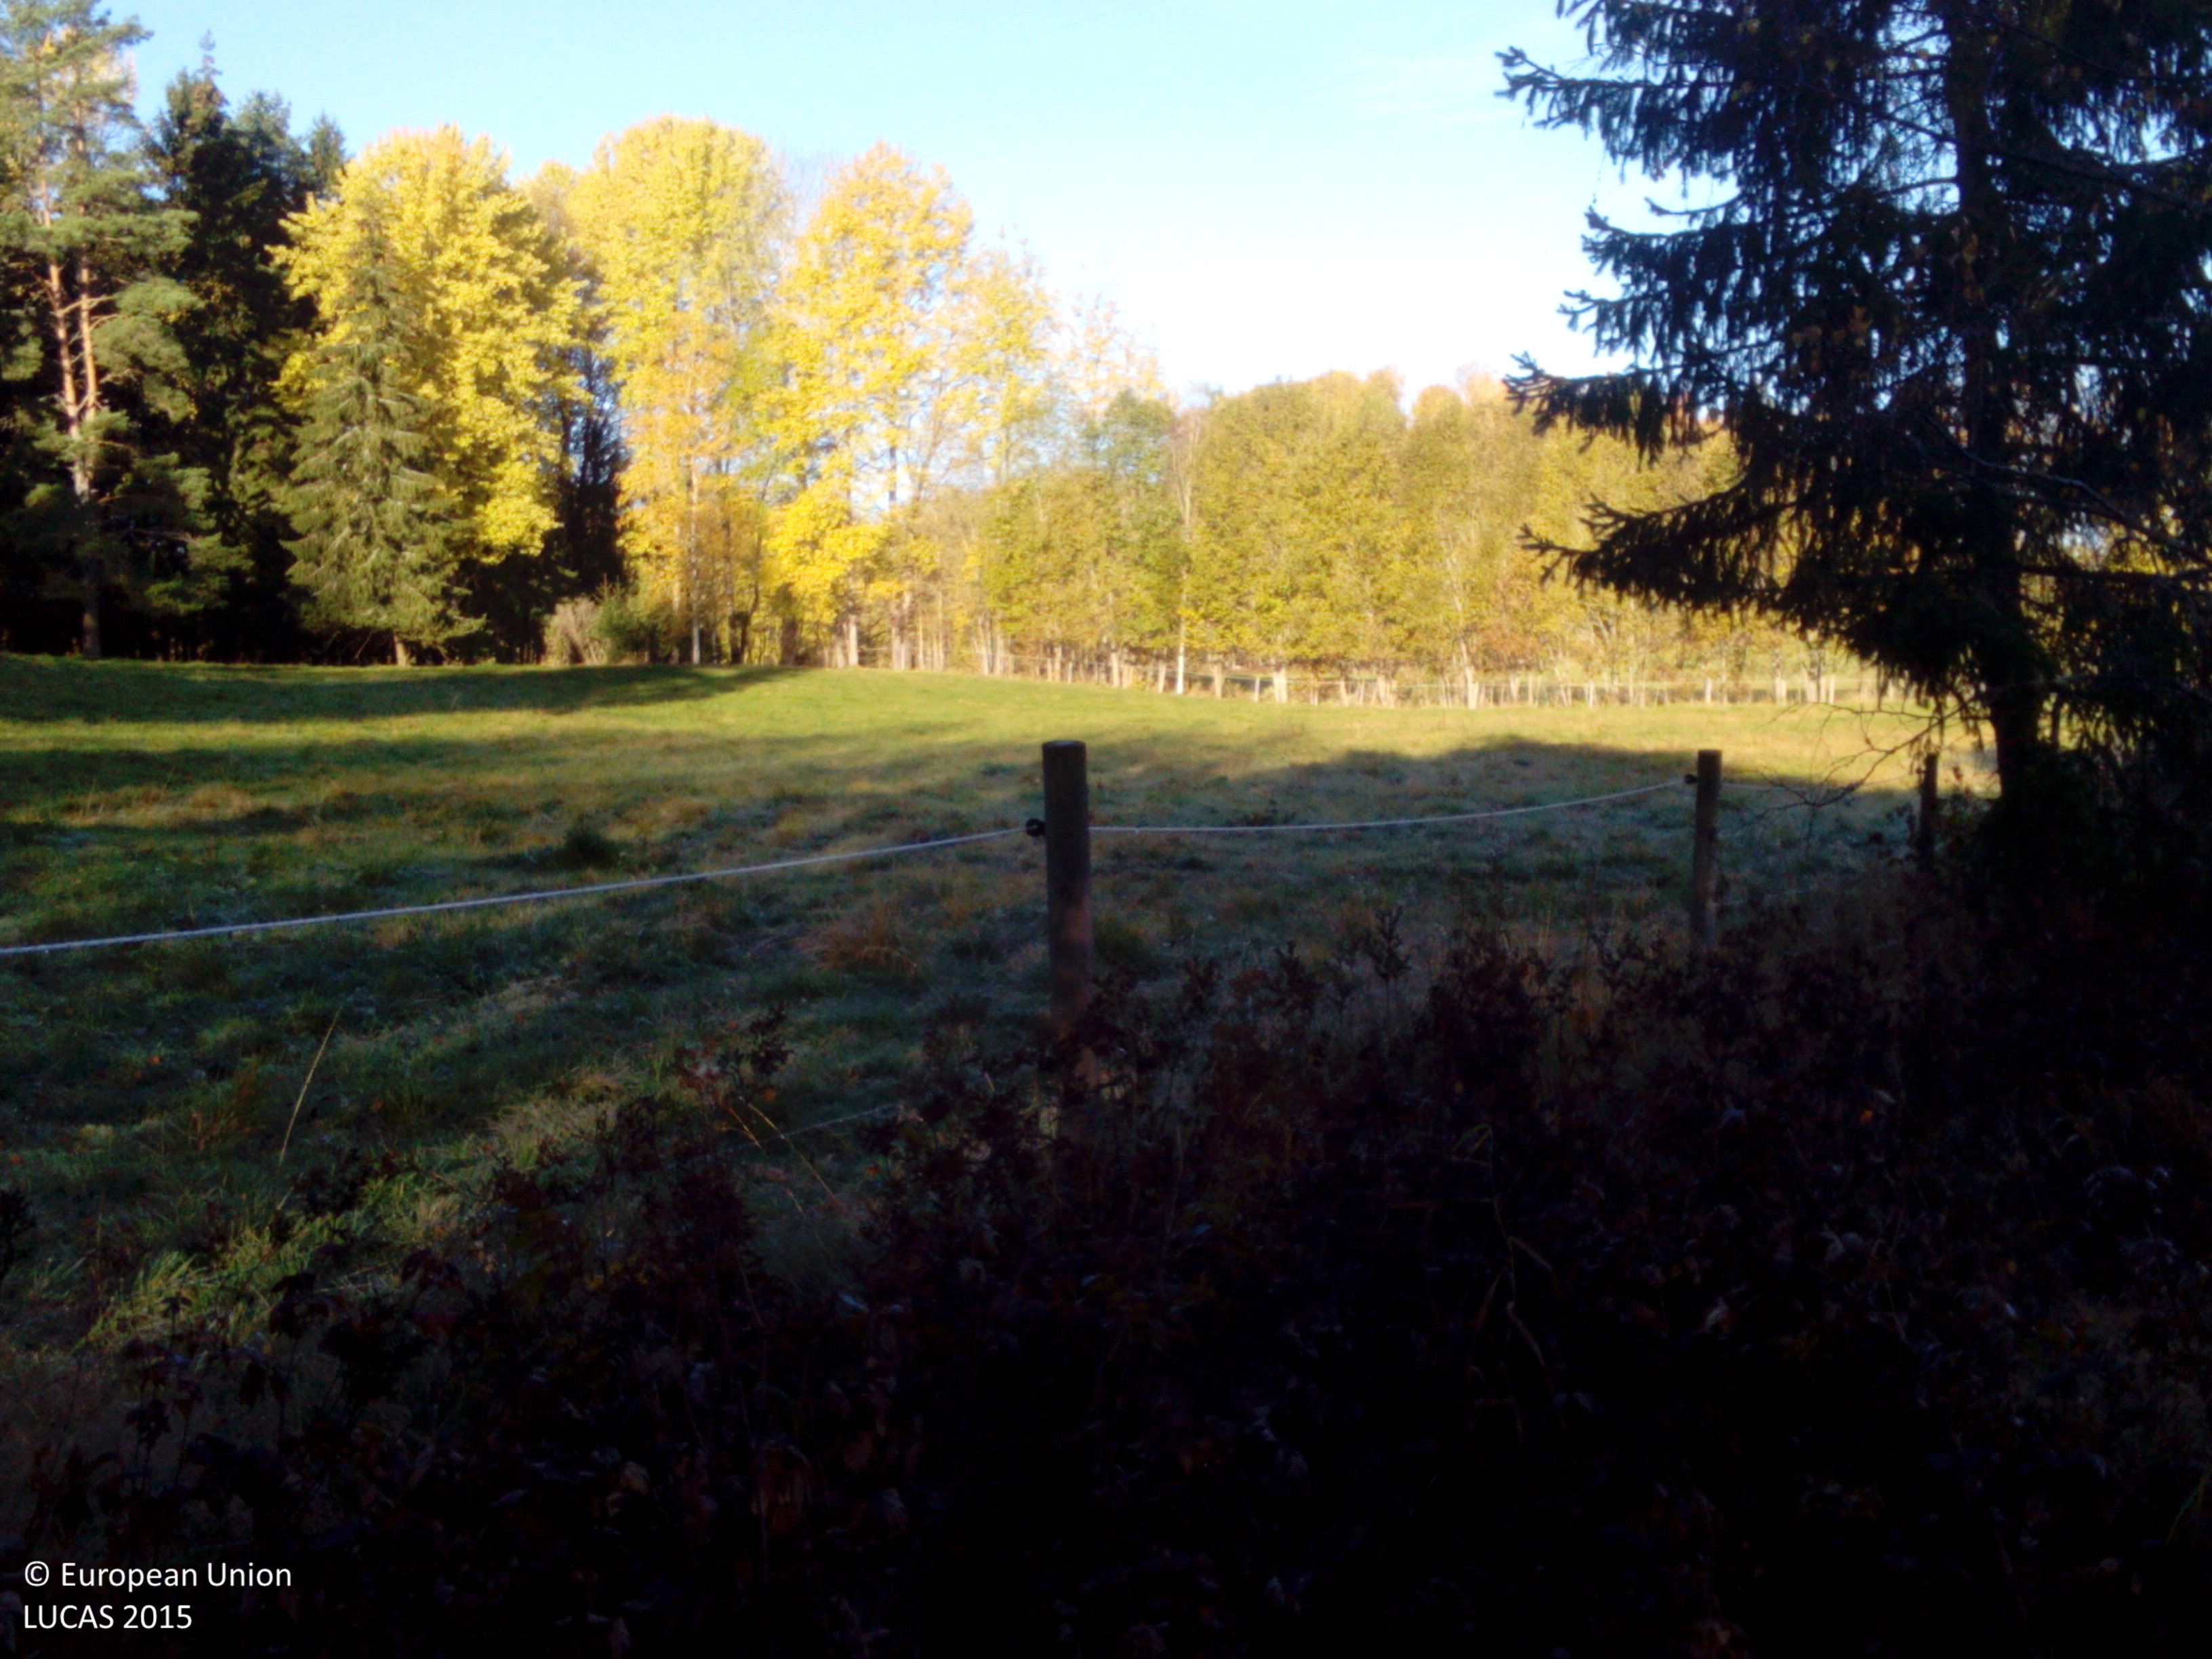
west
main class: Woodland
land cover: Broadleaved woodland
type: hemiboreal forest and nemoral coniferous forest and mixed broadleaved-coniferous forest
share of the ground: 25 - 50 %
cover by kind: herbaceous plants 60 %, broadleaved forest trees 40 %
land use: Semi-natural and natural areas not in use
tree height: > 5 m
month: October
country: SE
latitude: 59.1173
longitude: 16.3341
